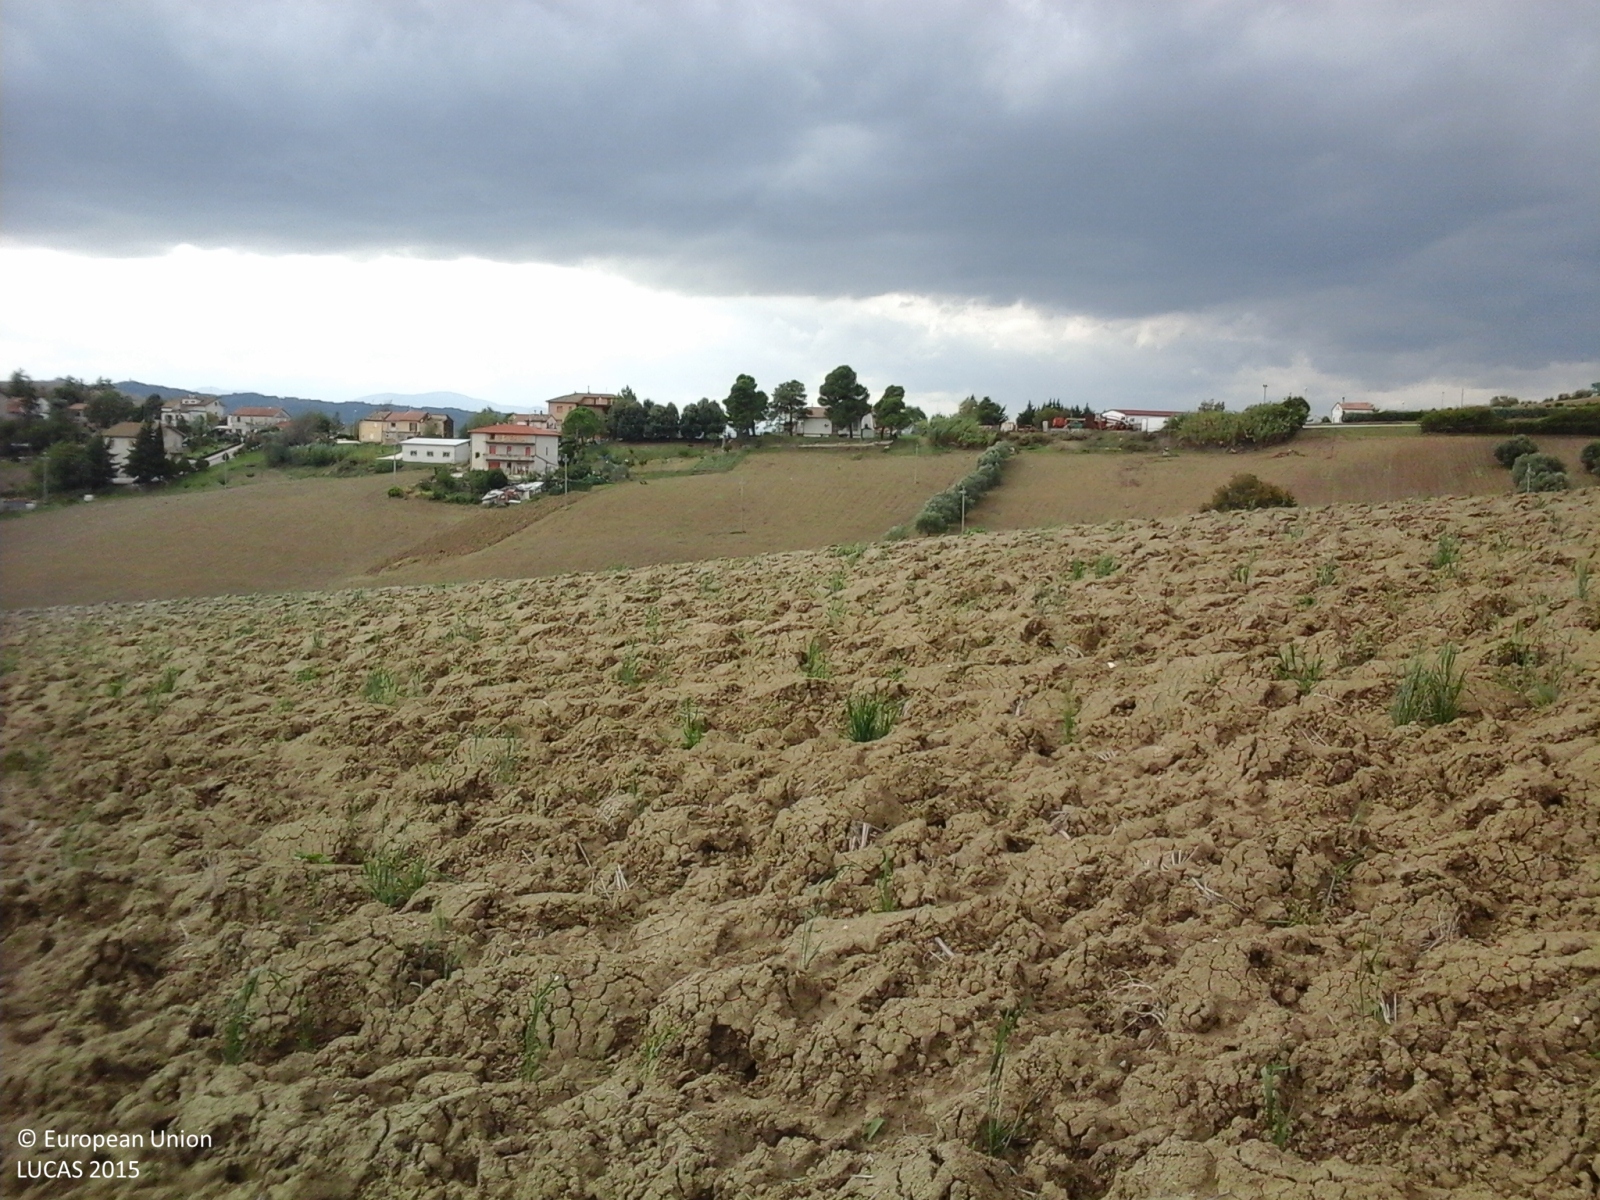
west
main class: Cropland
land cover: Durum wheat
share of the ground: < 10 %
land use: Agriculture (excluding fallow land and kitchen gardens)
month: October
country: IT
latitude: 43.5626
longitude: 13.1492
